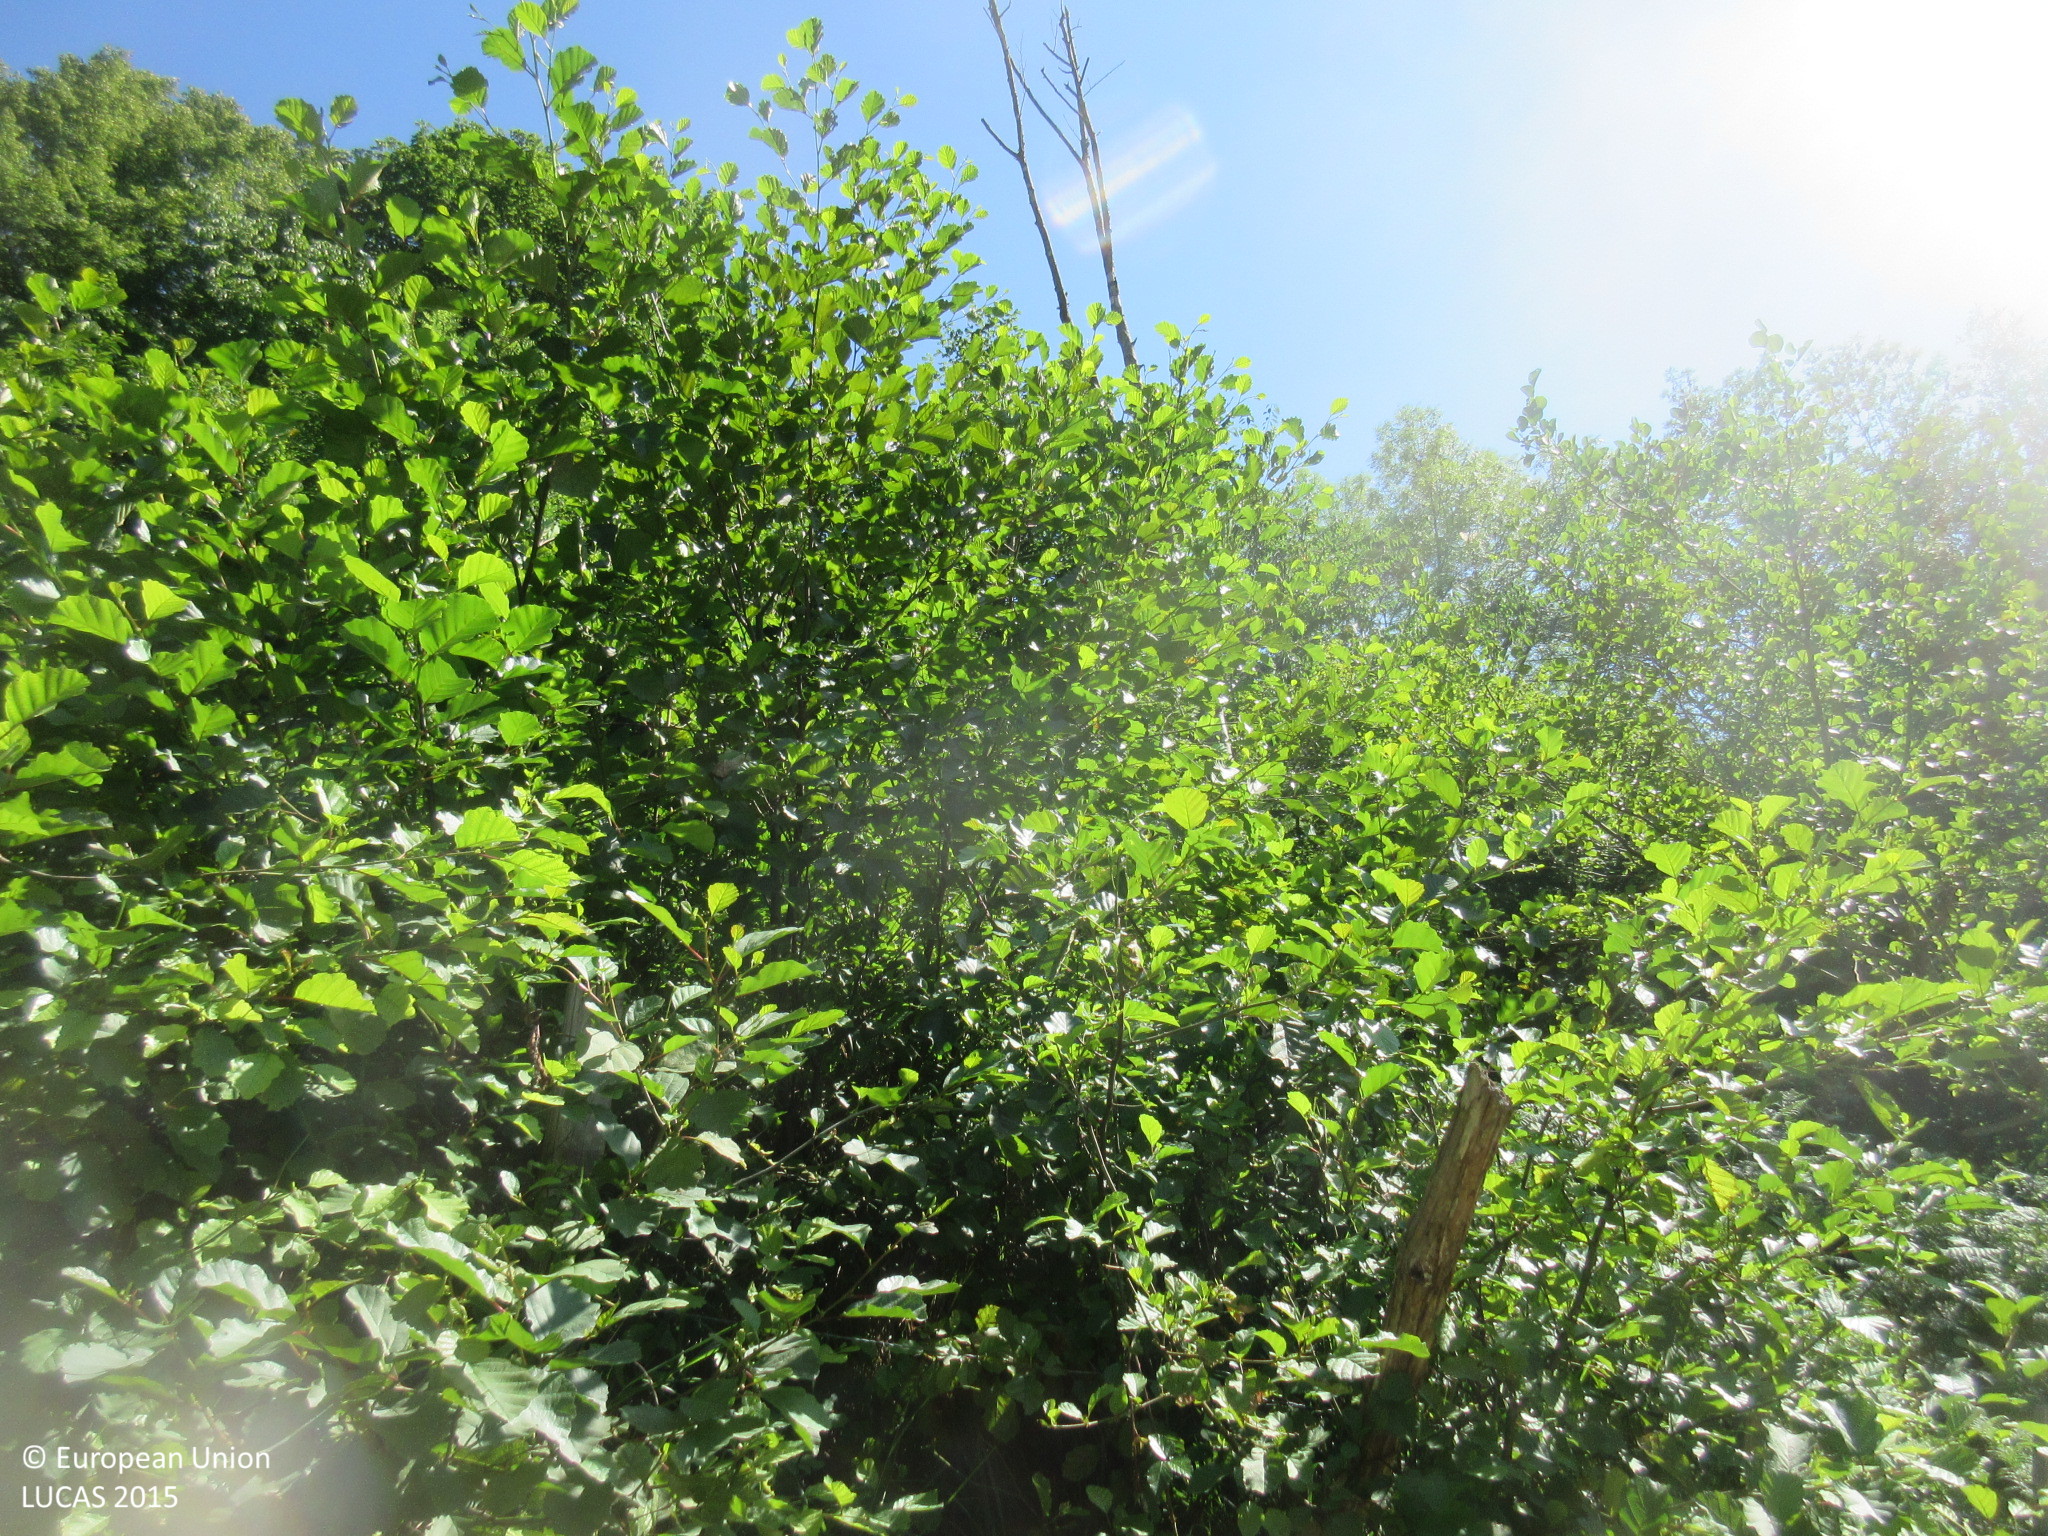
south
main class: Shrubland
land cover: Shrubland with sparse tree cover
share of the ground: > 75 %
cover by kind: shrubs 95 %, broadleaved forest trees 5 %
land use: Agriculture (excluding fallow land and kitchen gardens)
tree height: > 5 m
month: July
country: ES
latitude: 43.3289
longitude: -5.1051
